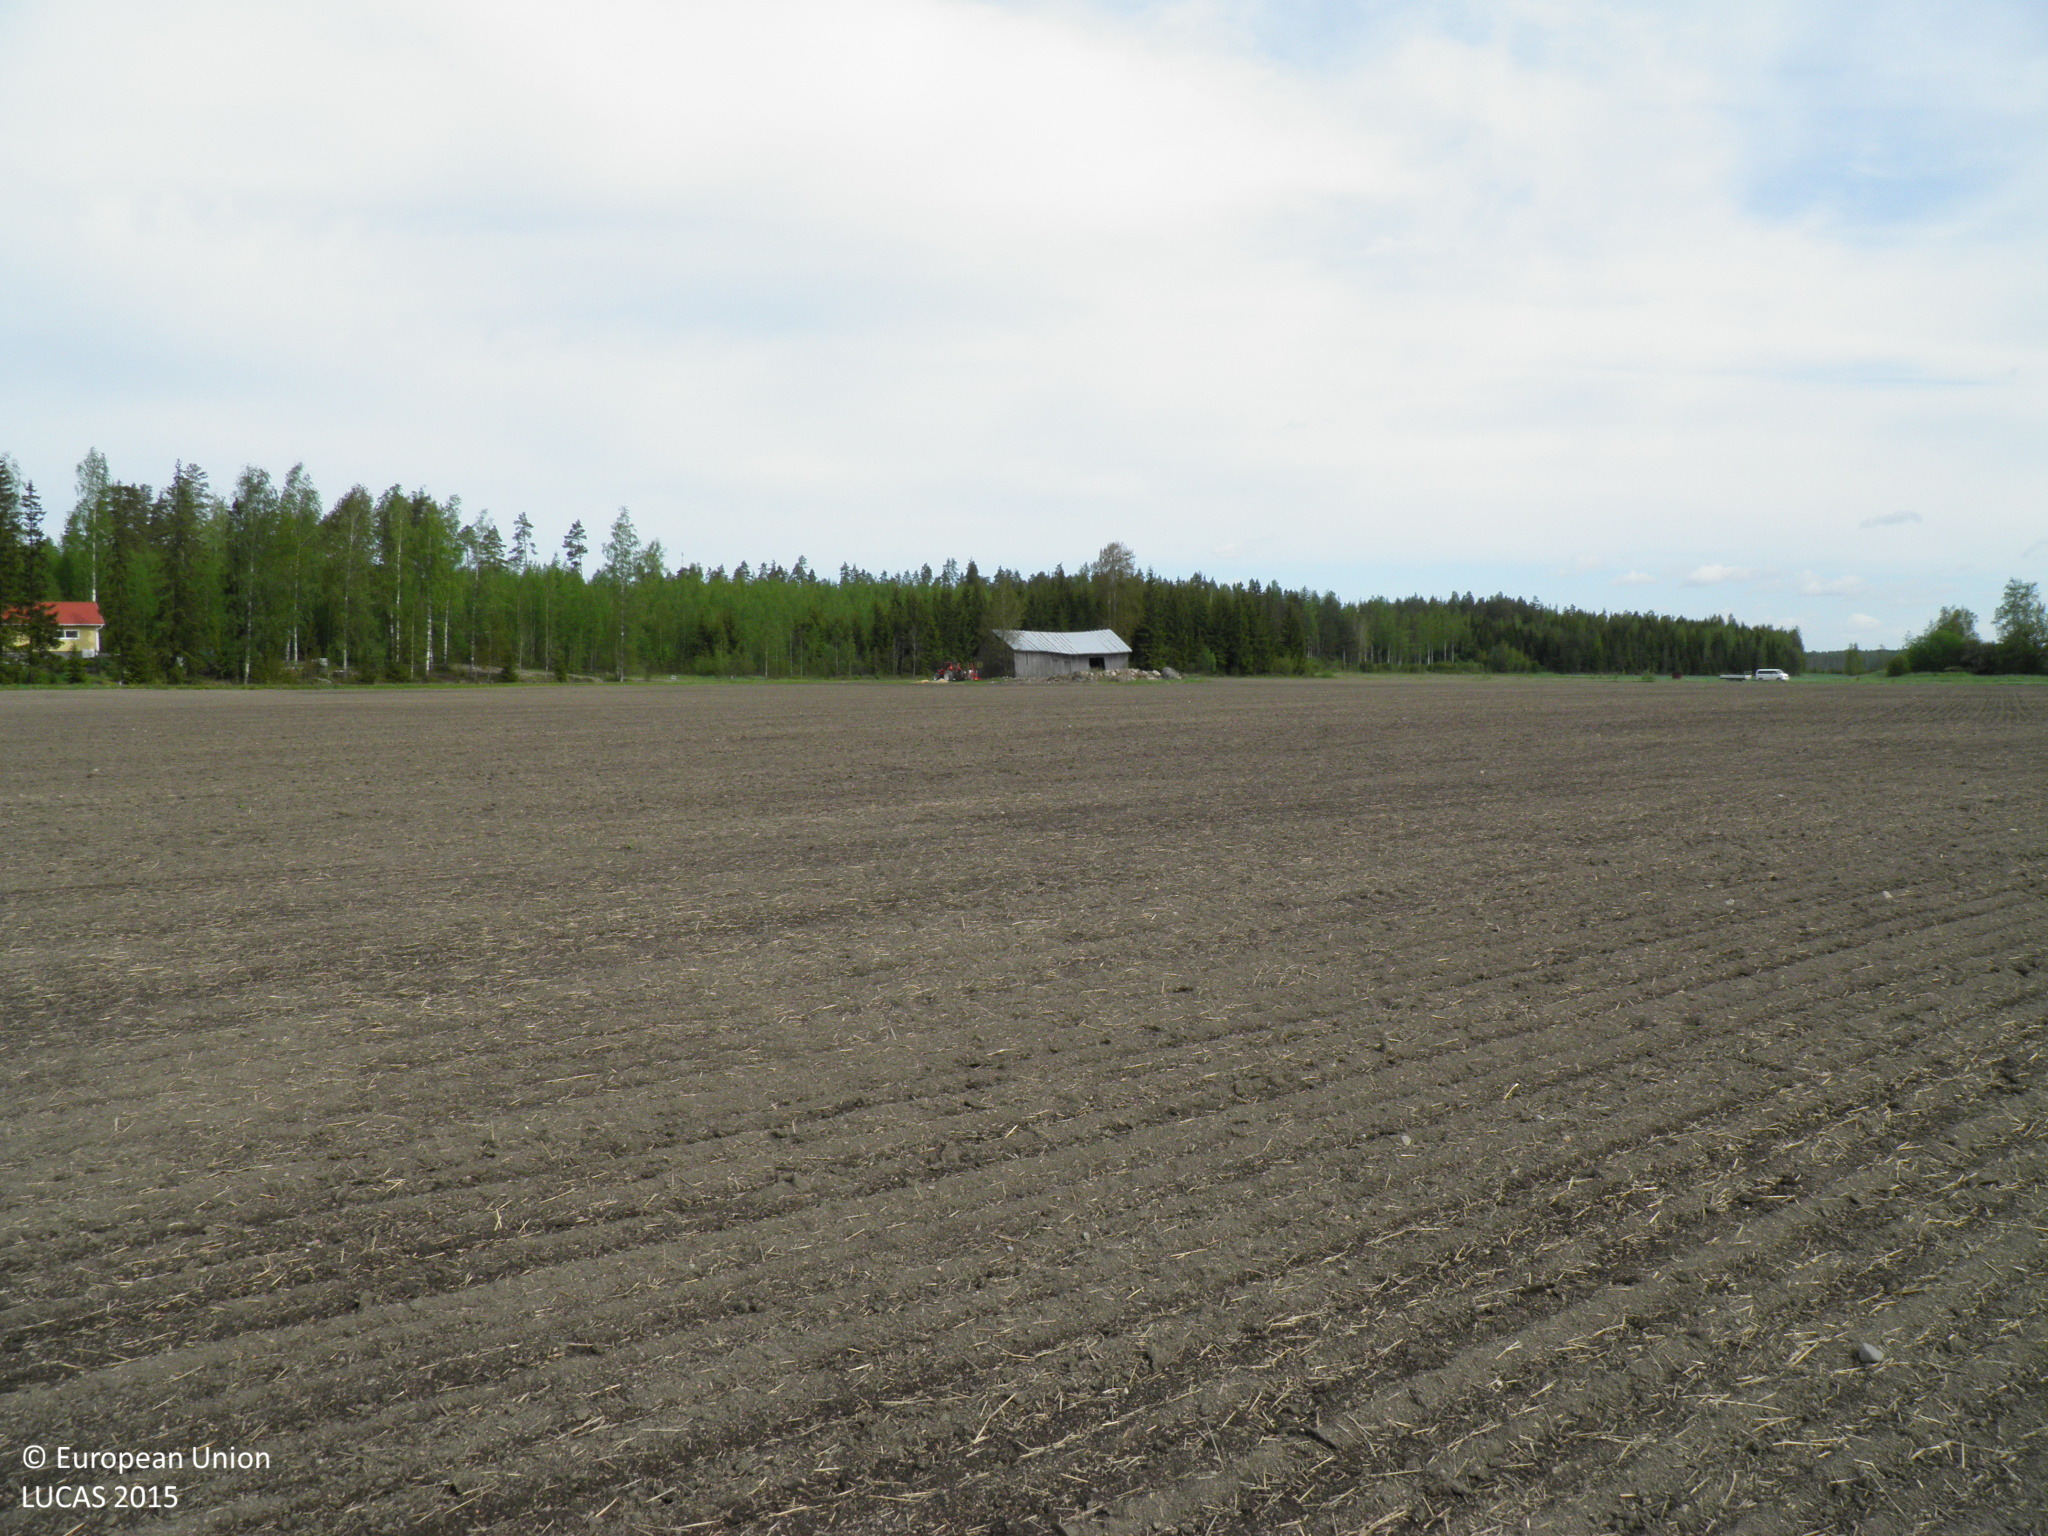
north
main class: Cropland
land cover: Common wheat
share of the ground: < 10 %
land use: Agriculture (excluding fallow land and kitchen gardens)
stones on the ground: < 10 %
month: June
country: FI
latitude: 60.5384
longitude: 22.6674
